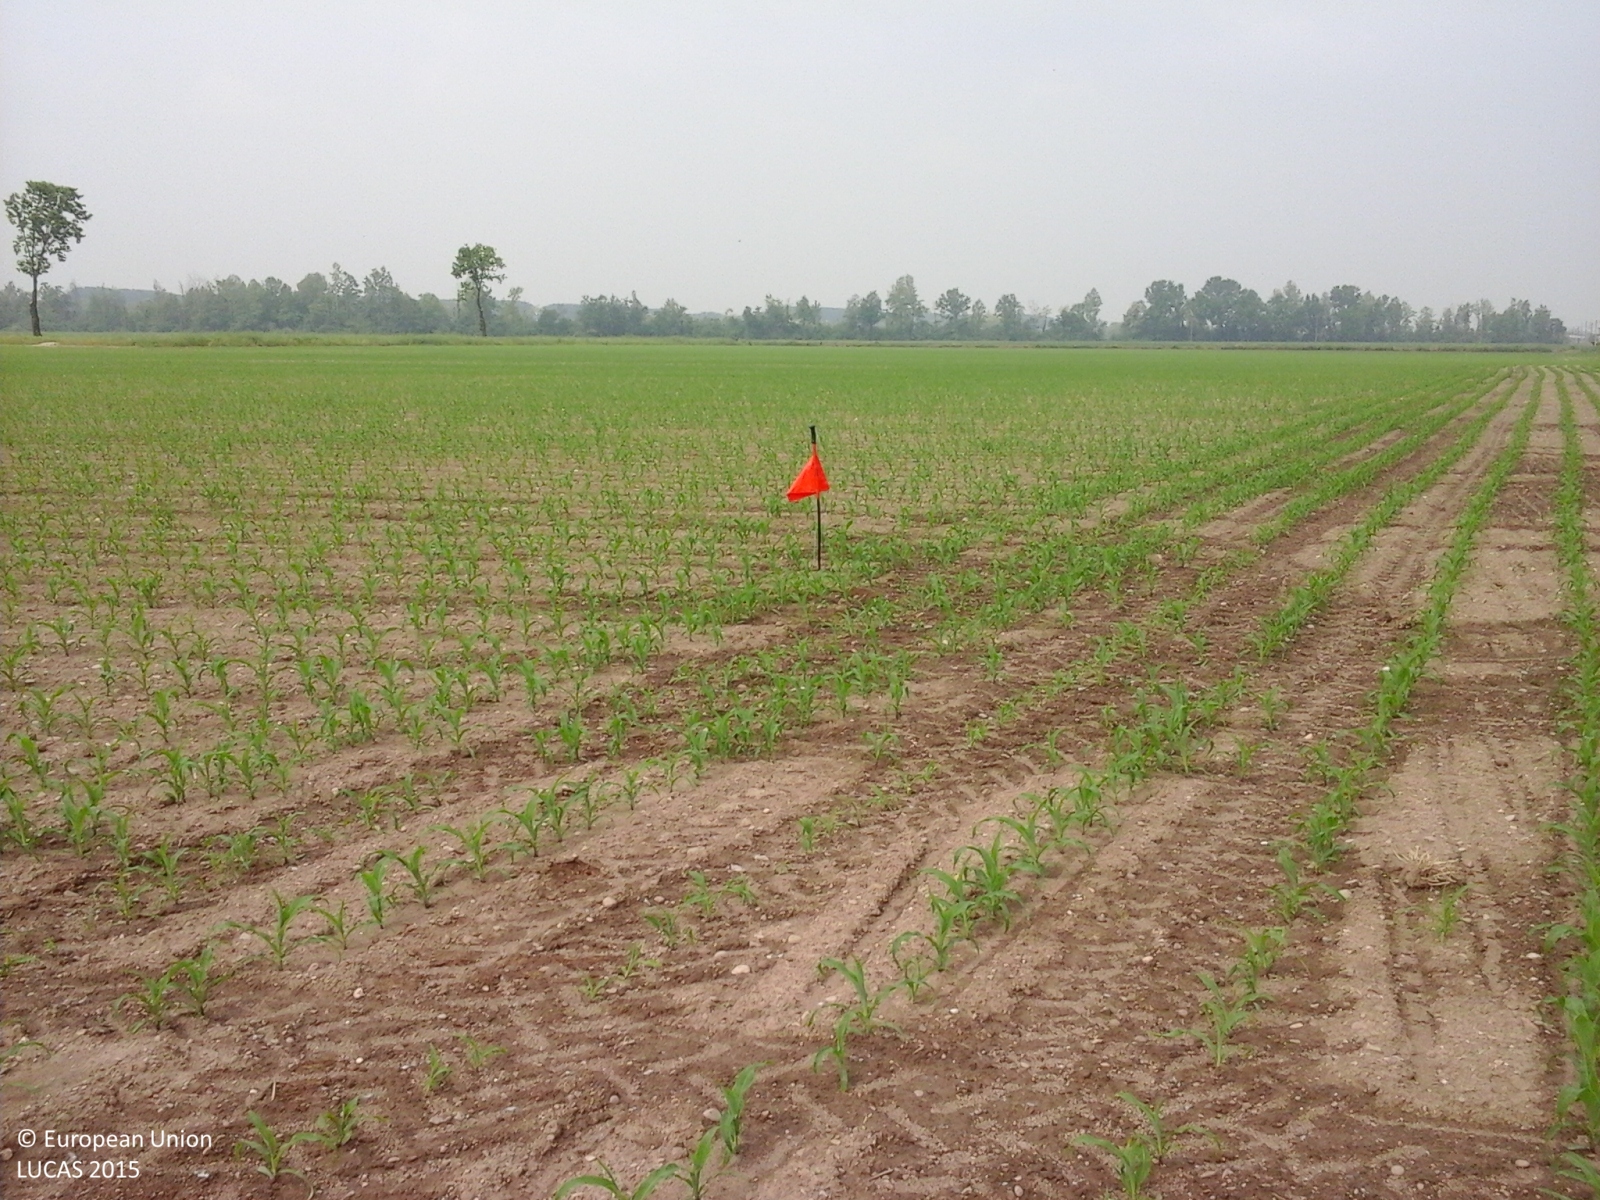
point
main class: Cropland
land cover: Maize
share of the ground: 10 - 25 %
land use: Agriculture (excluding fallow land and kitchen gardens)
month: May
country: IT
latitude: 45.3421
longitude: 9.8599
